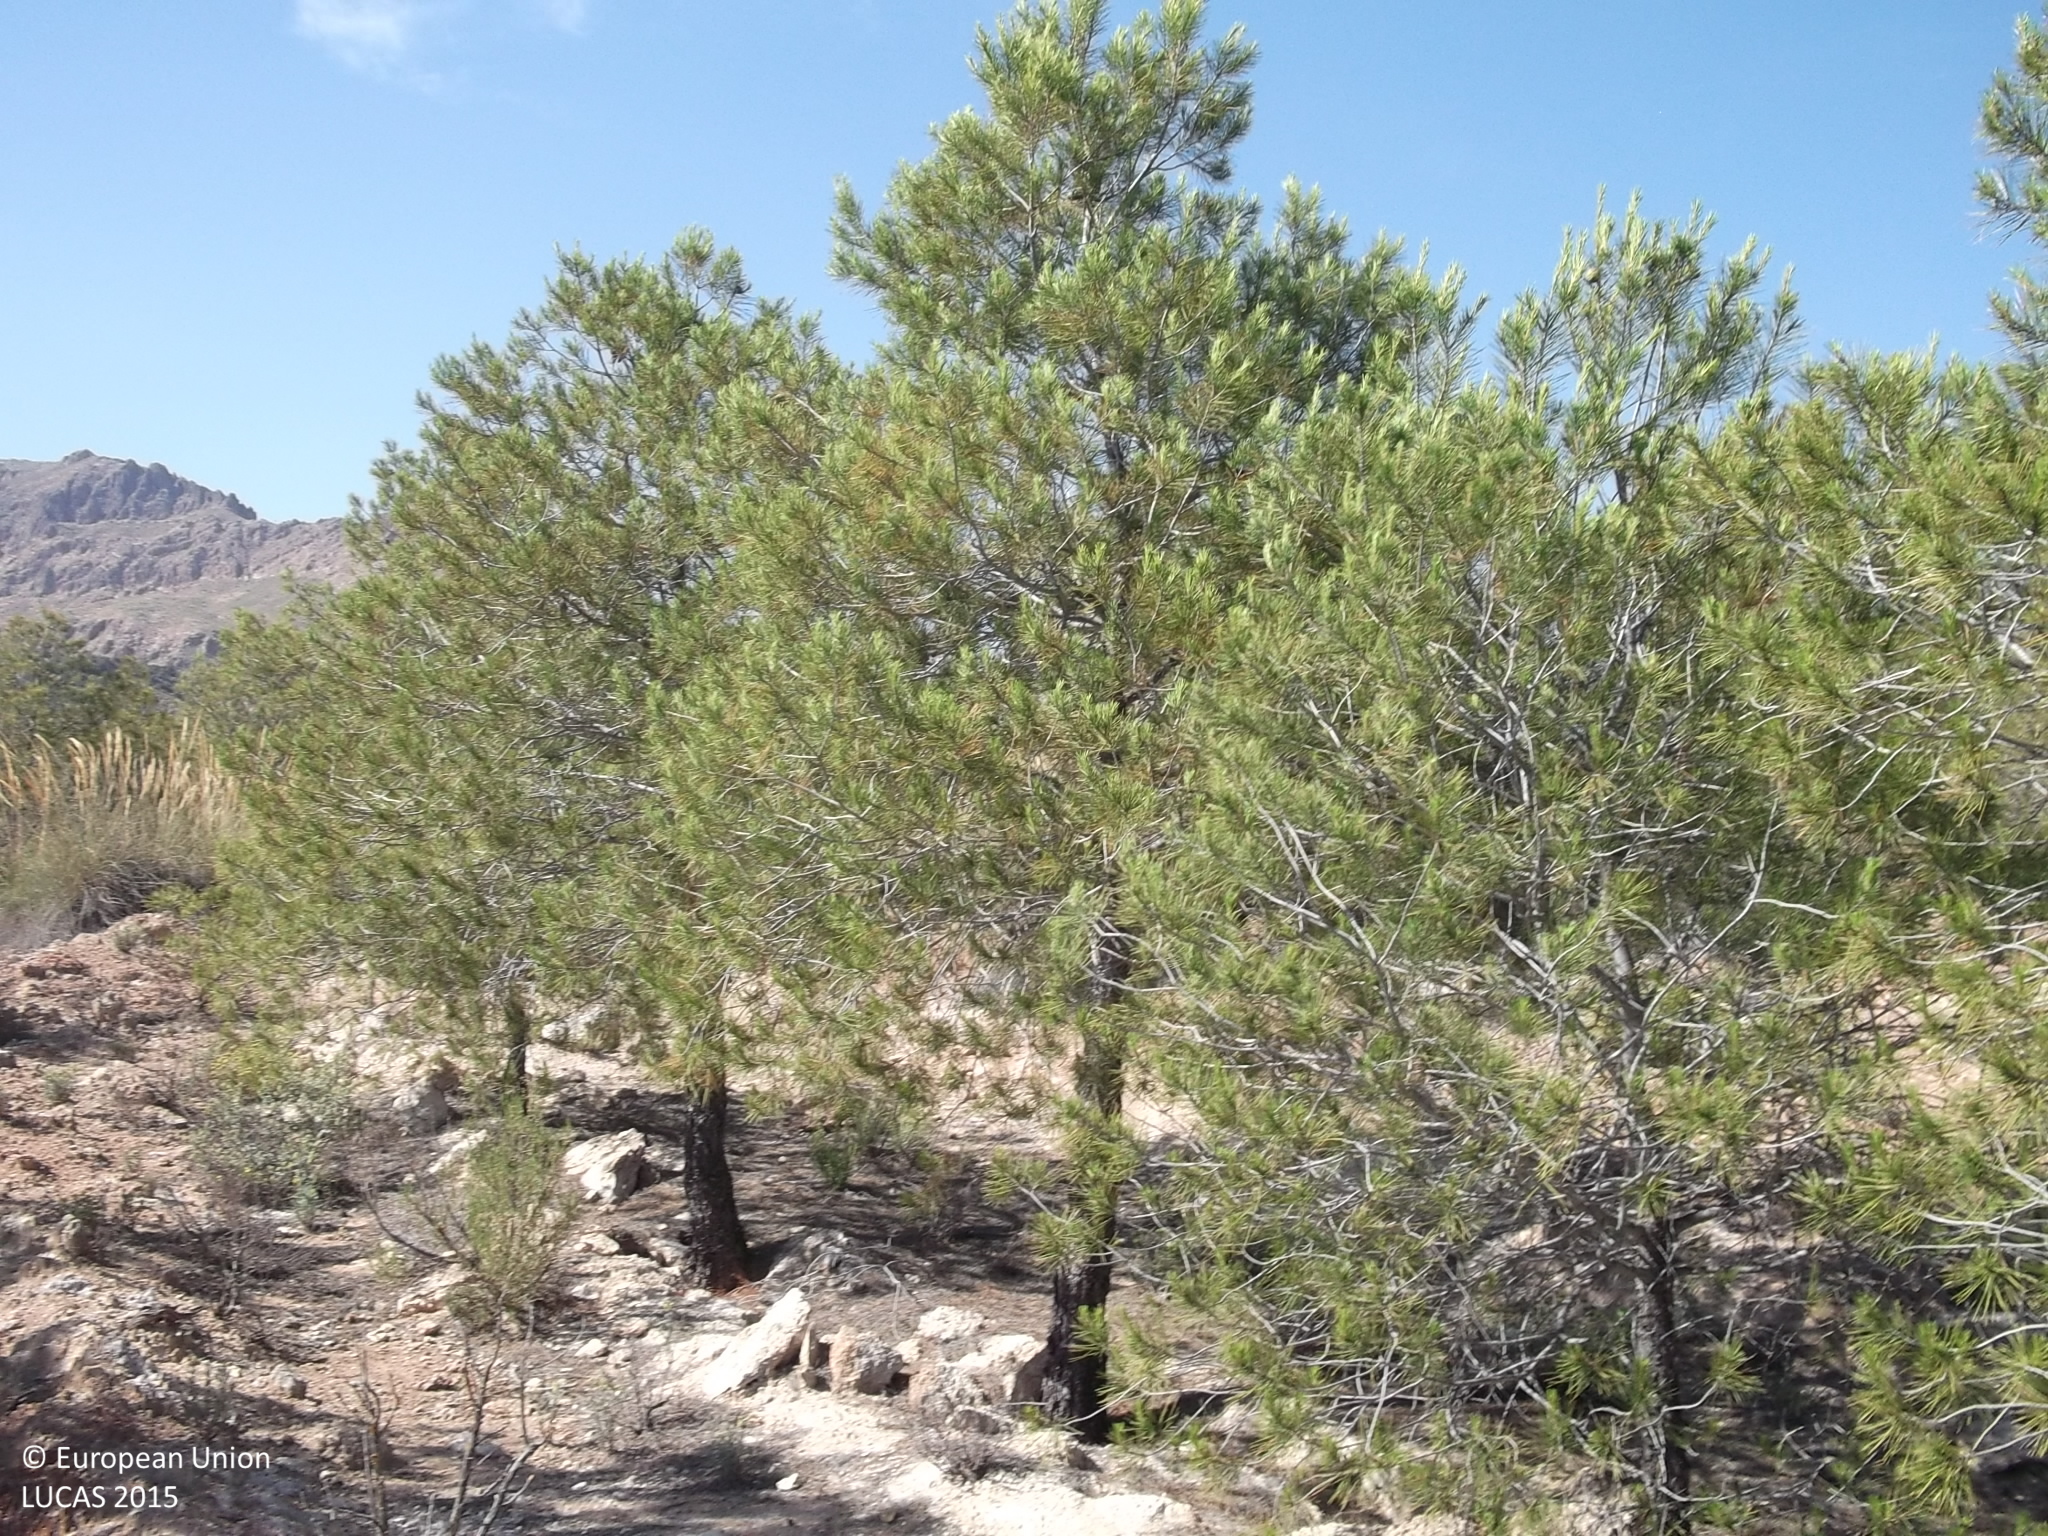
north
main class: Woodland
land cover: Pine dominated coniferous woodland
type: coniferous forest of the mediterranean region
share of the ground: 25 - 50 %
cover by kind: herbaceous plants 30 %, coniferous forest trees 25 %, shrubs 25 %, consolidated bare surface 20 %
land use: Semi-natural and natural areas not in use
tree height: > 5 m
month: June
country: ES
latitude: 38.2030
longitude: -1.6256
